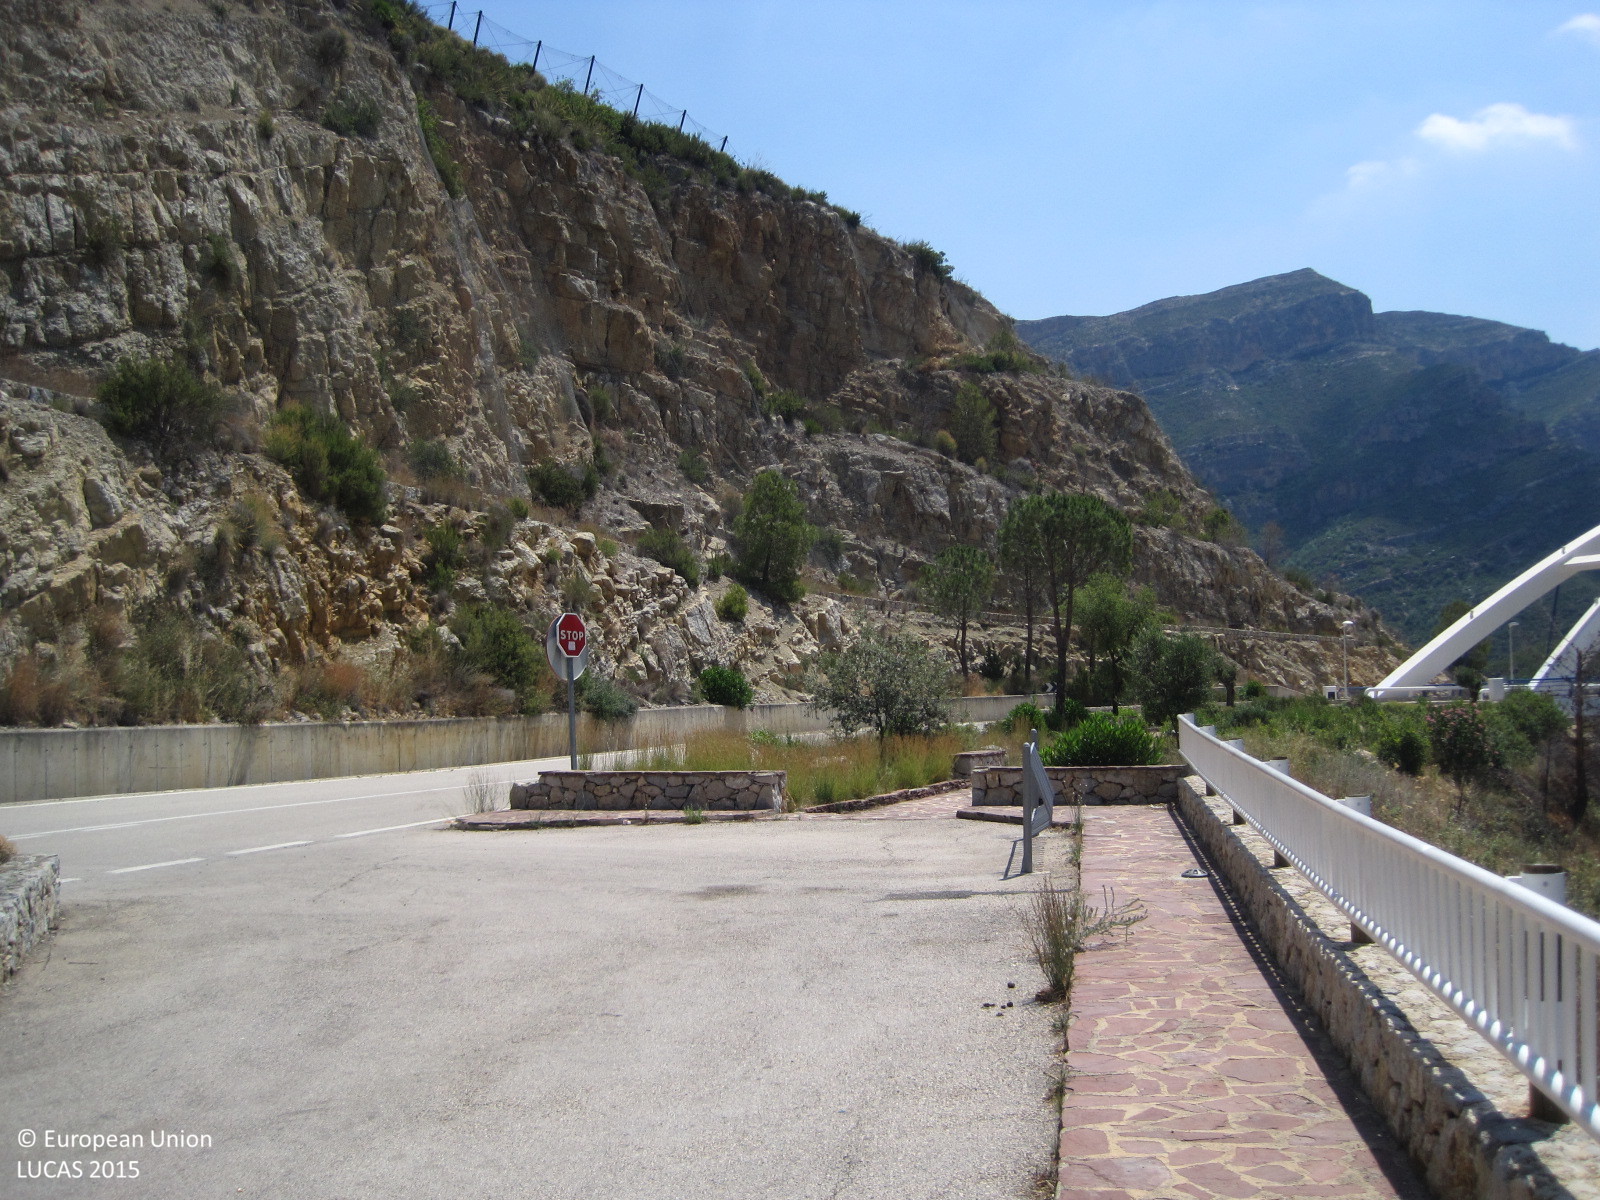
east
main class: Shrubland
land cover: Shrubland without tree cover
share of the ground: 25 - 50 %
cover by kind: lichens and mosses 50 %, shrubs 40 %, herbaceous plants 10 %
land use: Semi-natural and natural areas not in use
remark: Burnt area
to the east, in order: Shrubland without tree cover
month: June
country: ES
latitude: 39.2693
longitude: -0.7881
